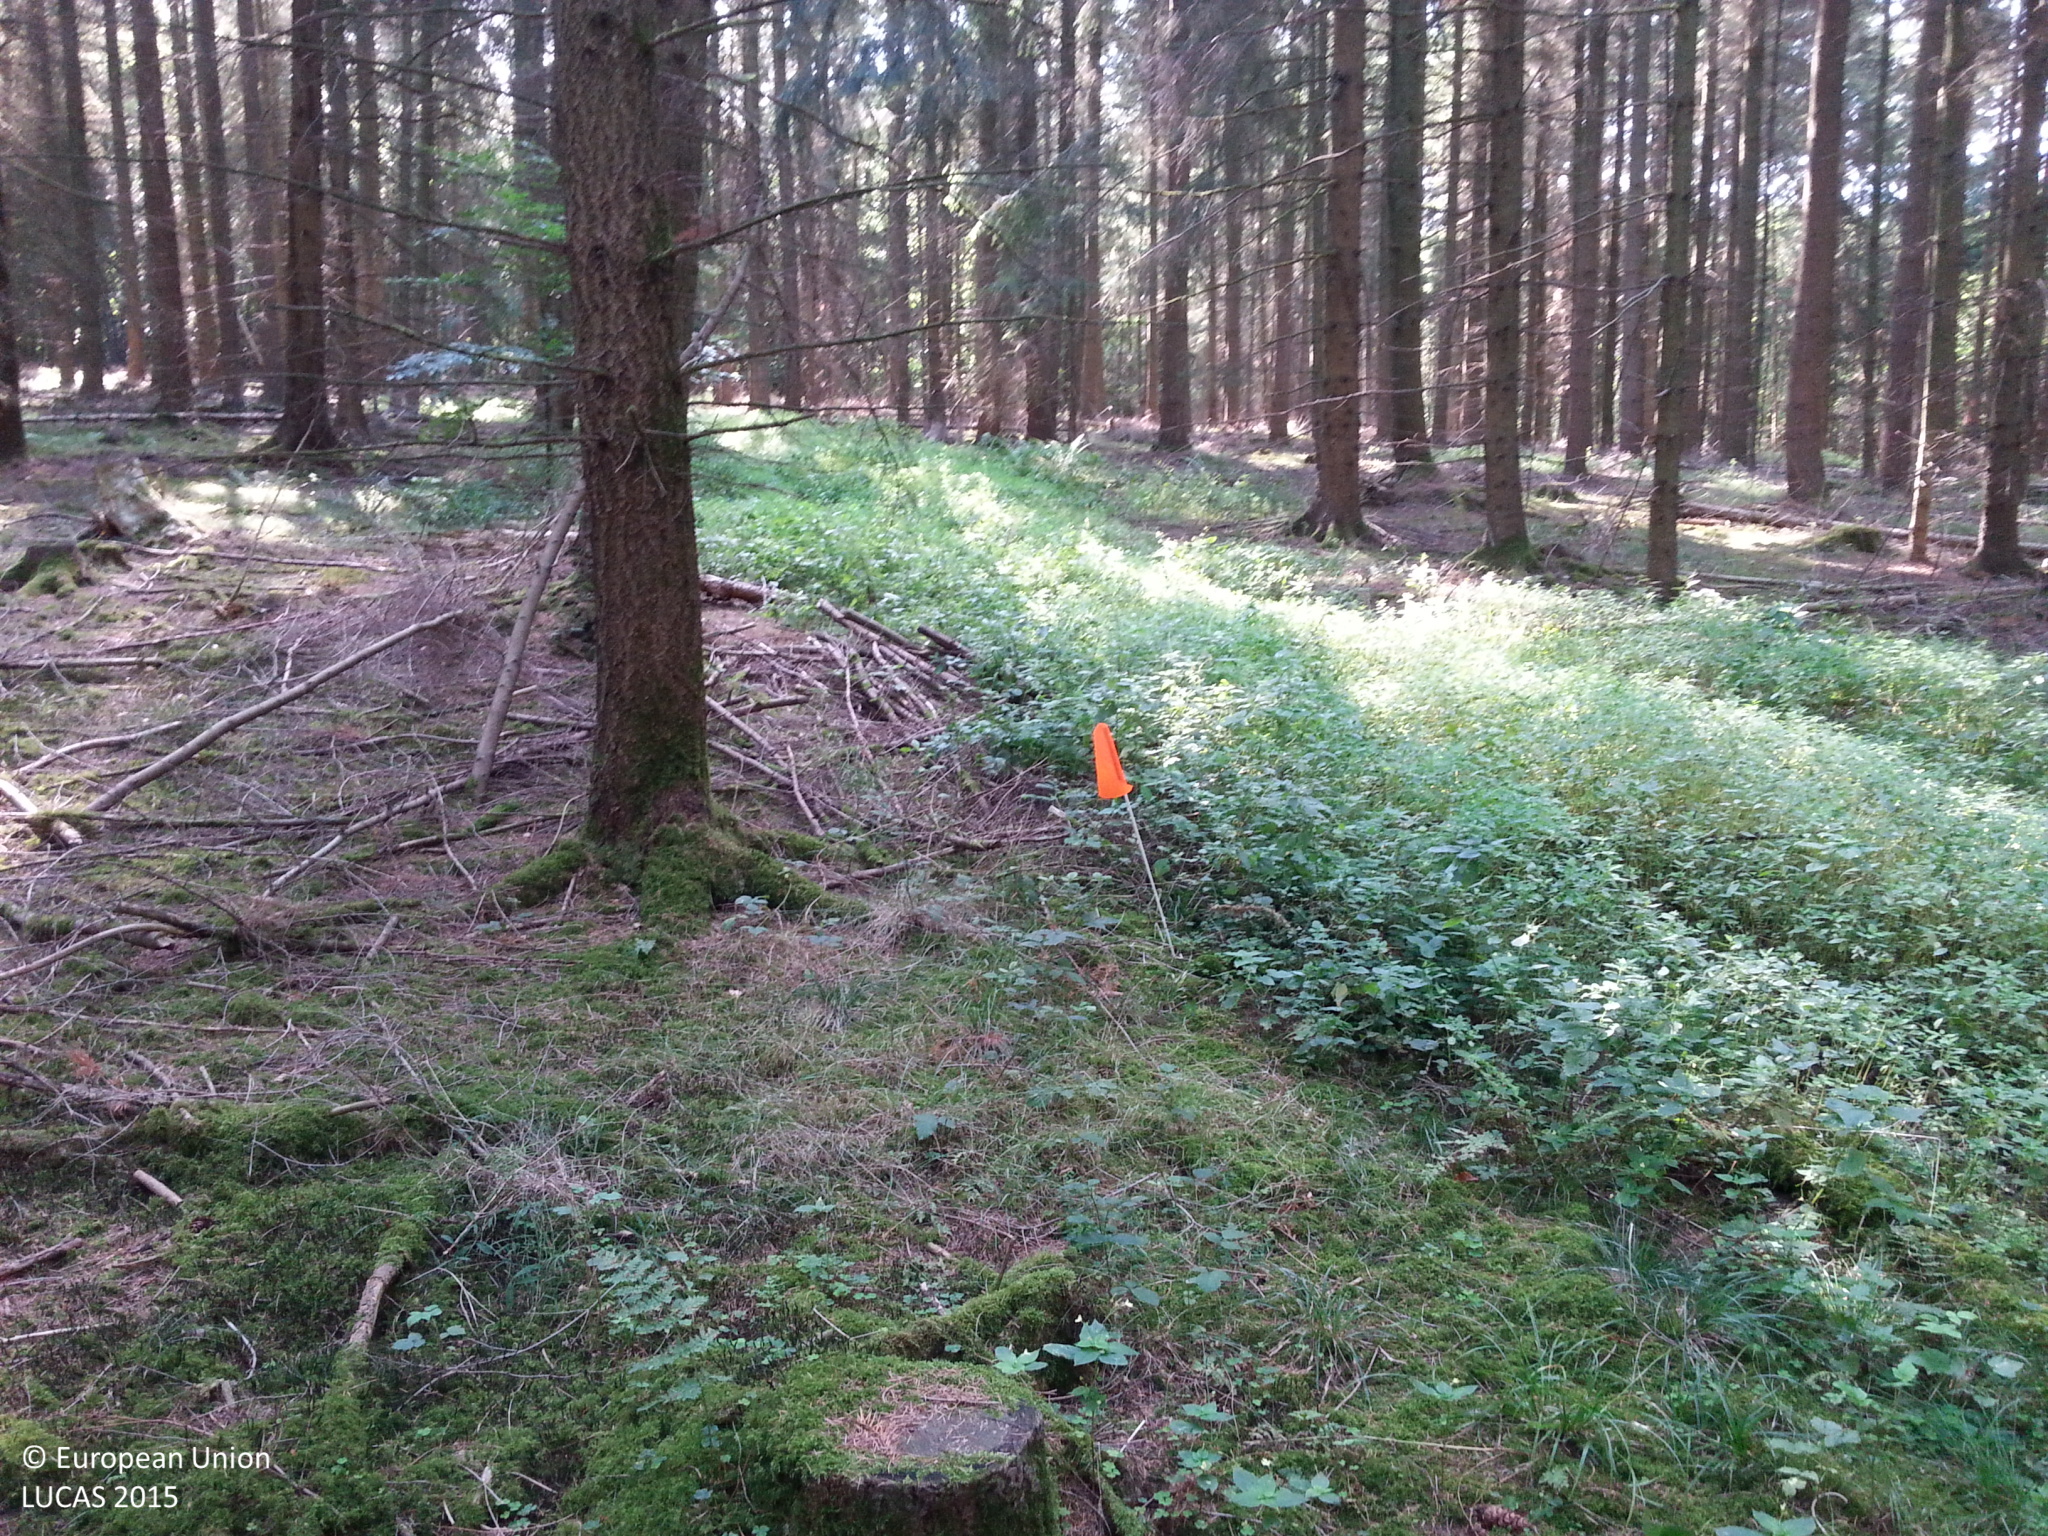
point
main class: Woodland
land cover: Spruce dominated coniferous woodland
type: boreal forest
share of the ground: > 75 %
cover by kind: coniferous forest trees 80 %, herbaceous plants 10 %, lichens and mosses 10 %
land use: Forestry
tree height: > 5 m
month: September
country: DE
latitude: 49.3554
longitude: 9.4082
